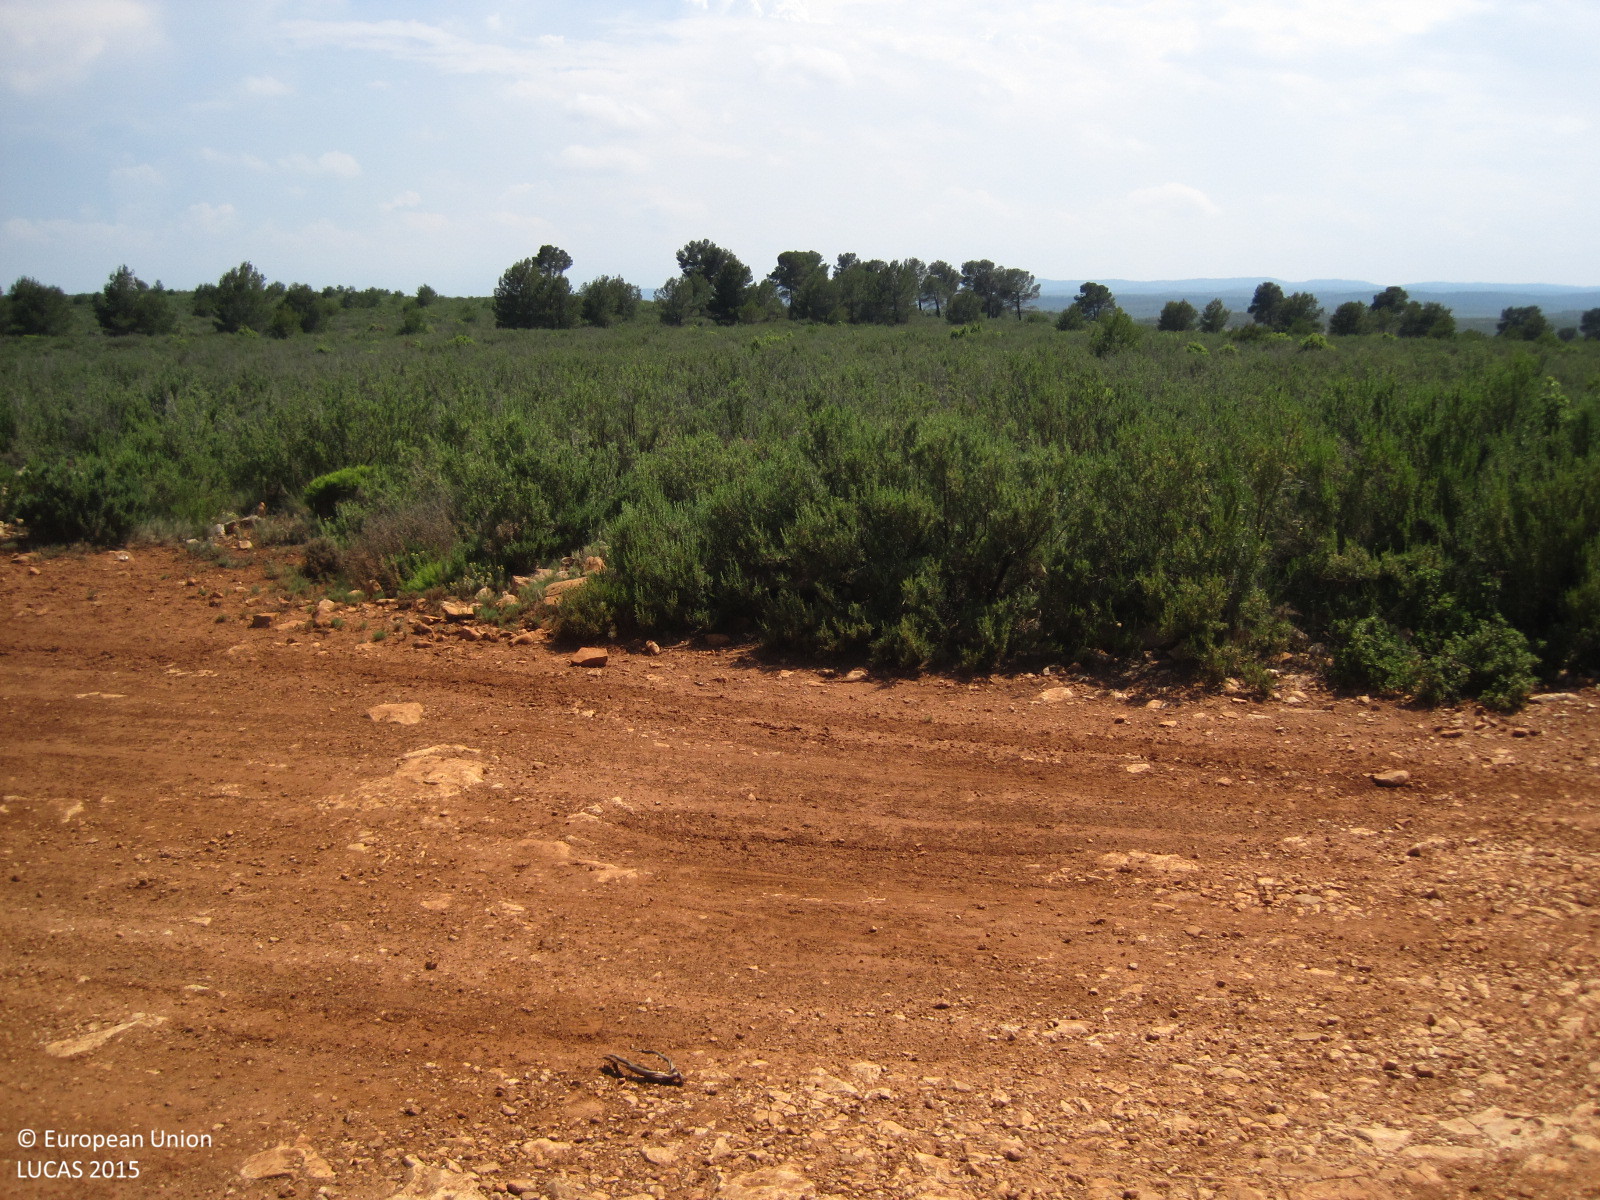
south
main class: Shrubland
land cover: Shrubland without tree cover
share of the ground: > 75 %
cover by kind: shrubs 85 %, consolidated bare surface 10 %, herbaceous plants 5 %
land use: Semi-natural and natural areas not in use
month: June
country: ES
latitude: 39.2437
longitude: -0.8537
